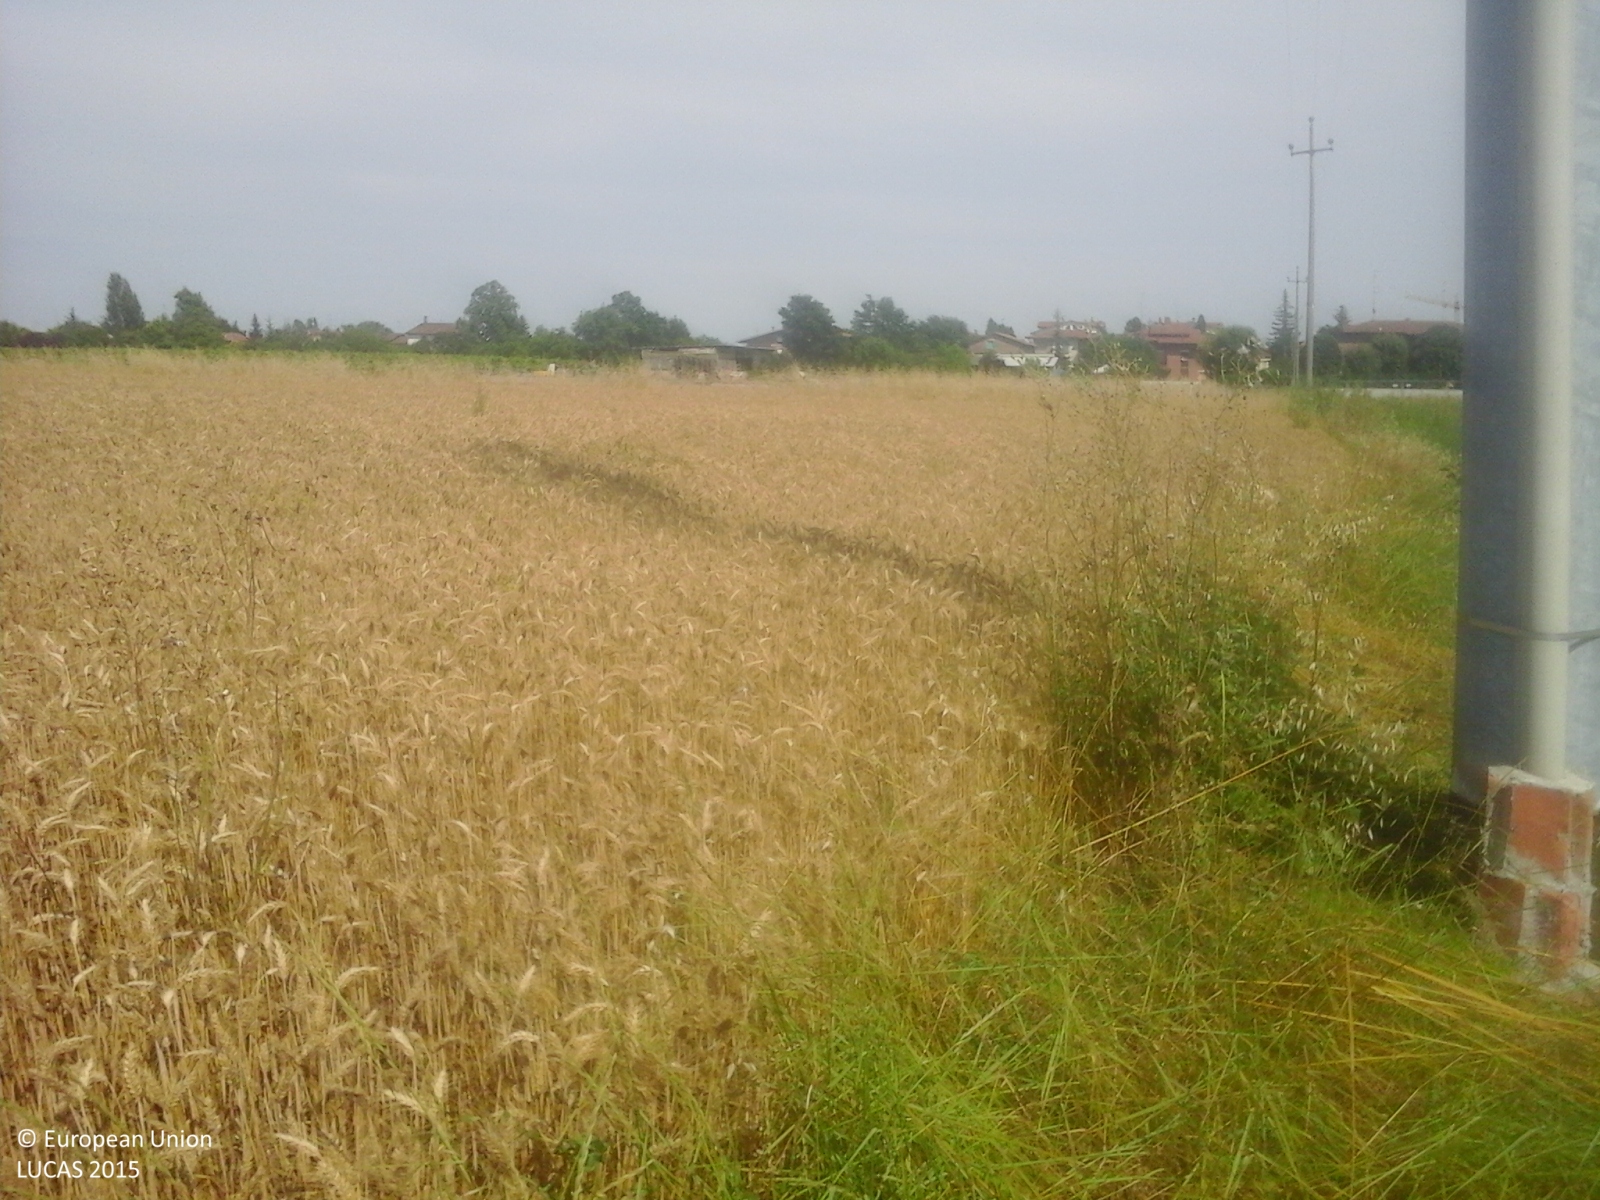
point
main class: Cropland
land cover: Common wheat
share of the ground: > 75 %
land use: Agriculture (excluding fallow land and kitchen gardens)
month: June
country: IT
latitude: 44.6880
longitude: 11.0451
